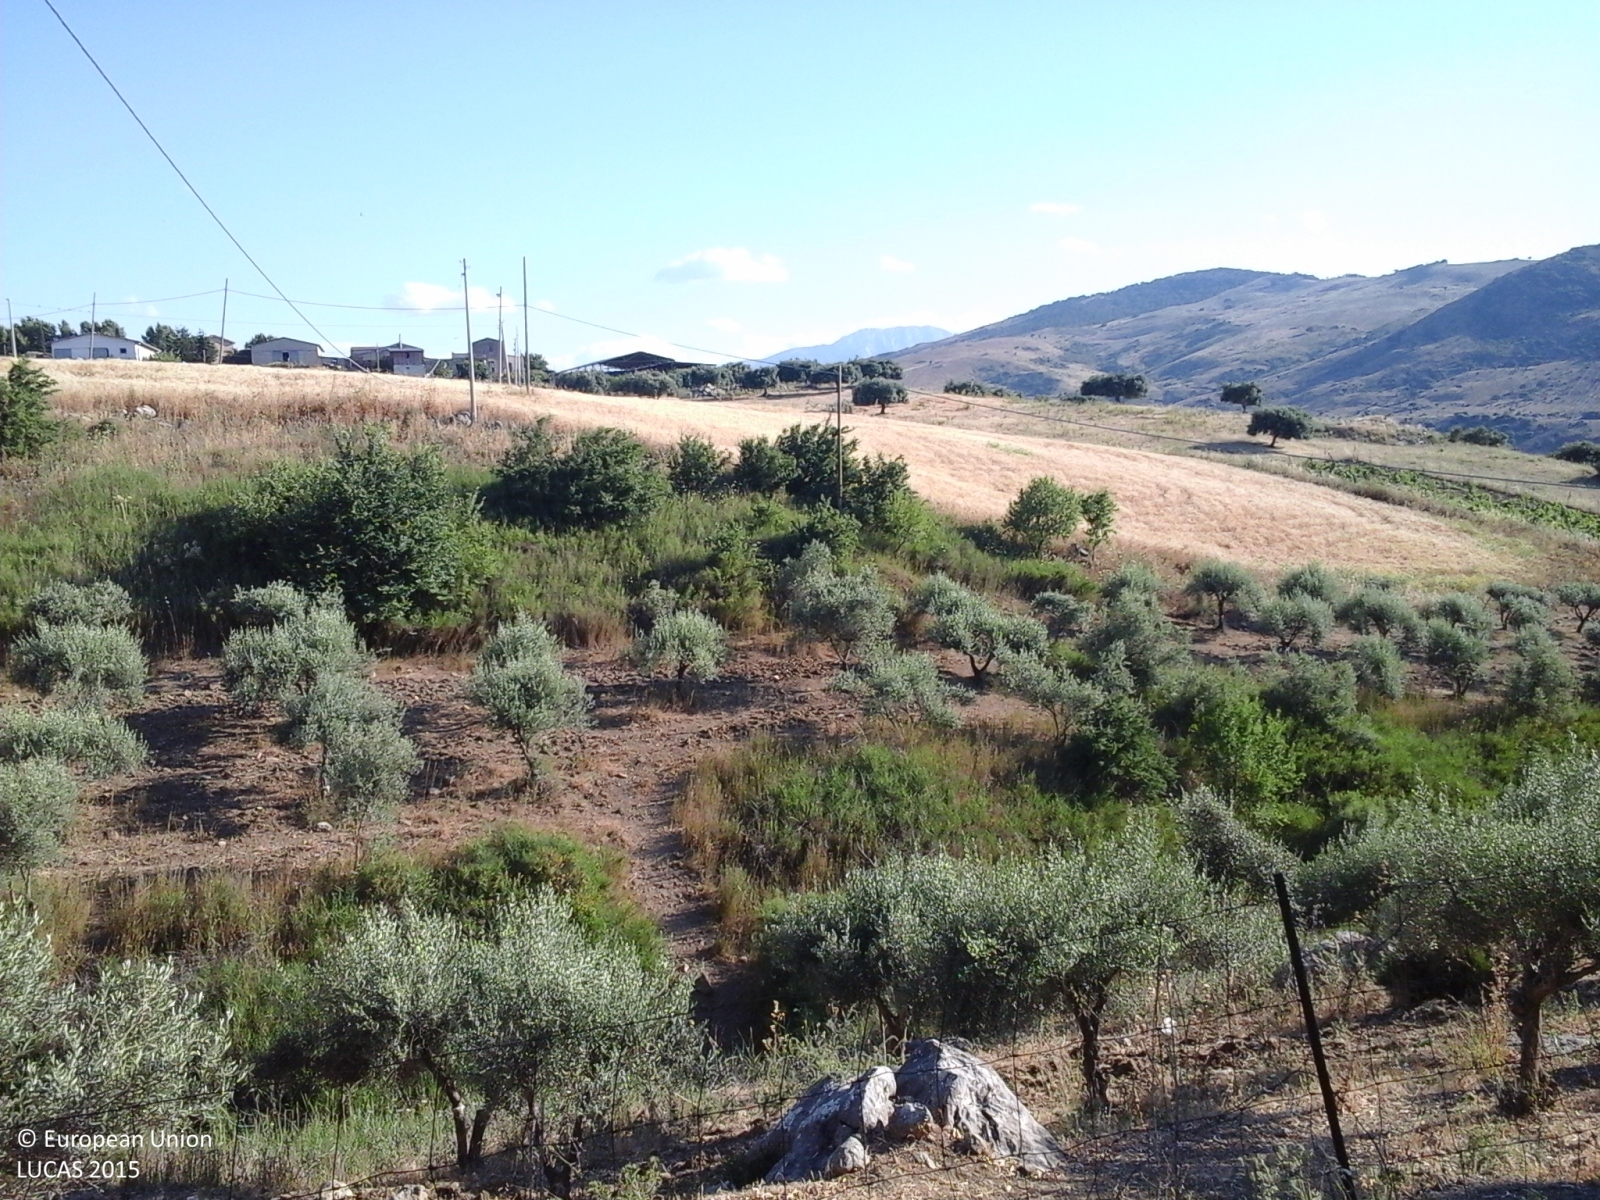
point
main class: Cropland
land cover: Olive groves
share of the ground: 50 - 75 %
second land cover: Other bare soil
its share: > 75 %
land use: Agriculture (excluding fallow land and kitchen gardens)
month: June
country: IT
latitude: 37.9913
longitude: 13.5163
